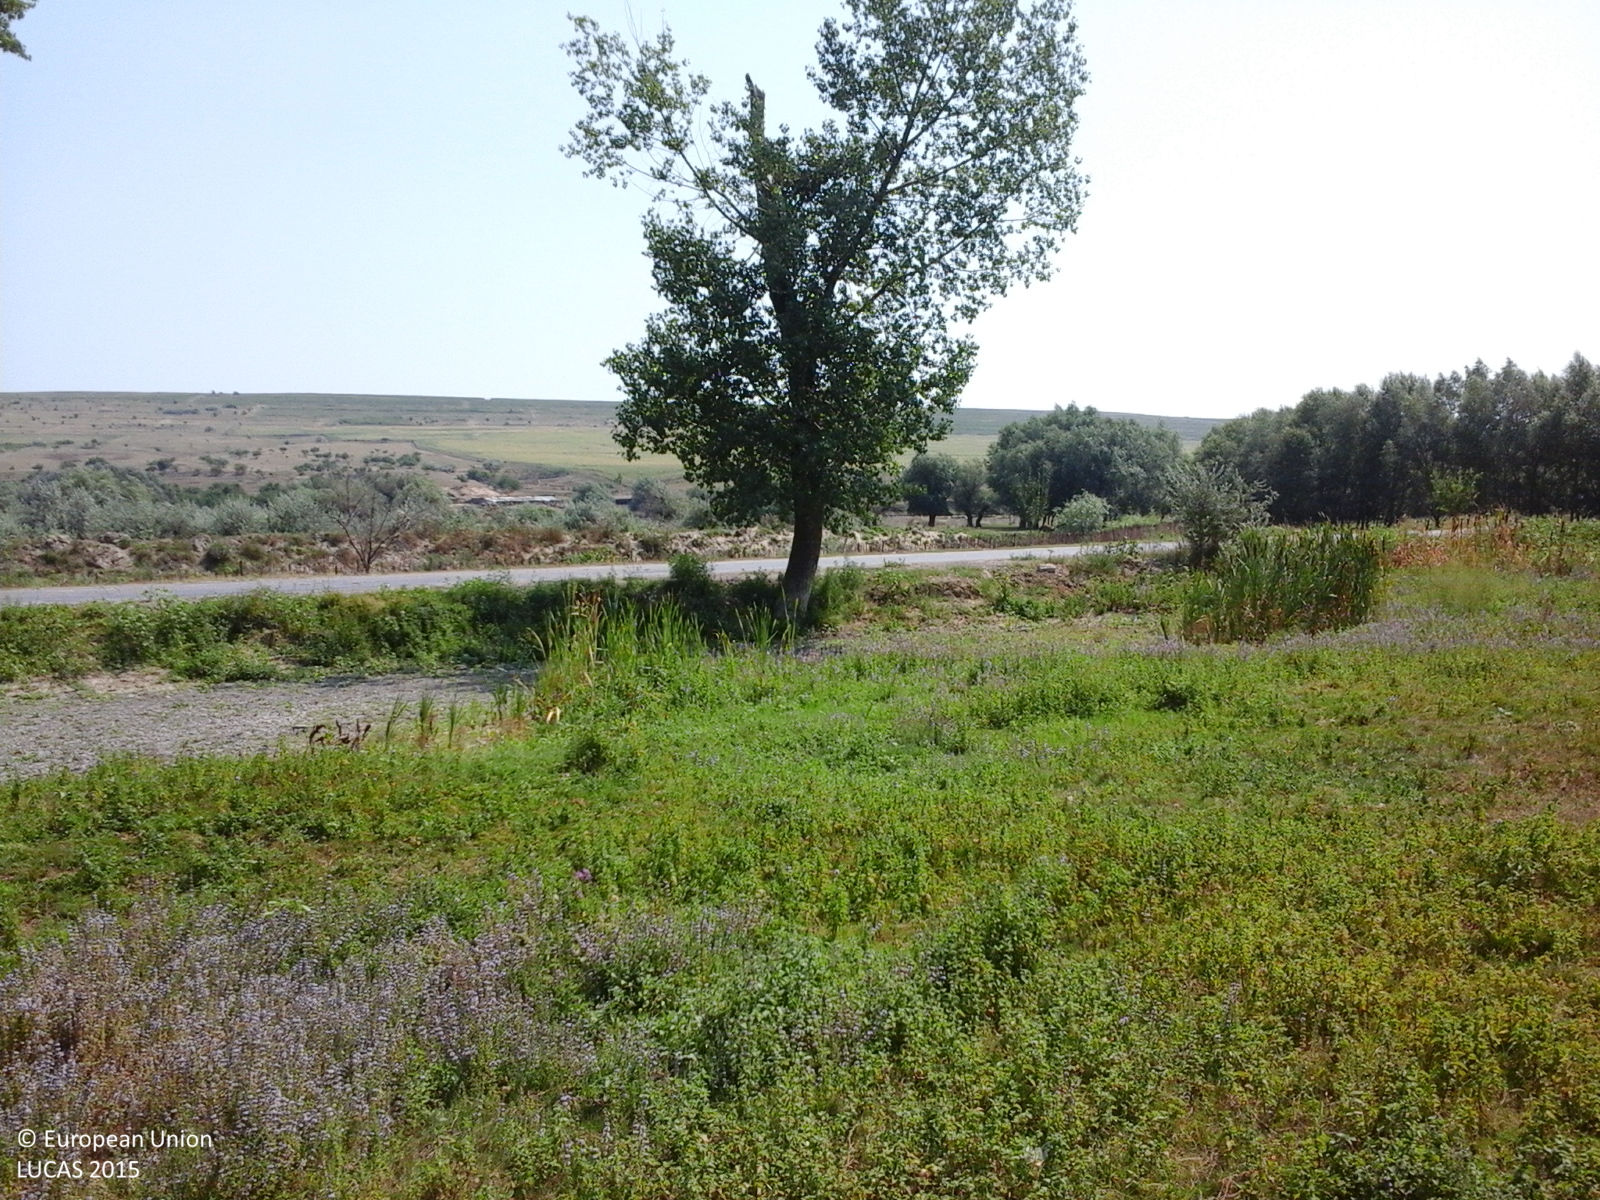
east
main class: Grassland
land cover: Grassland without tree/shrub cover
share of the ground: > 75 %
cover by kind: herbaceous plants 100 %
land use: Agriculture (excluding fallow land and kitchen gardens)
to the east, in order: Grassland without tree/shrub cover; Single bushes/trees; Grass margins; Paved roads, cycling and walking lanes; Spontaneously vegetated surfaces; Fences; Lucerne; Fences; Abandoned hedges; Inland fresh running water; Grassland with sparse tree/shrub cover; Electric lines; Railways; Single bushes/trees
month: July
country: RO
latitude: 45.8350
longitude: 27.9234
